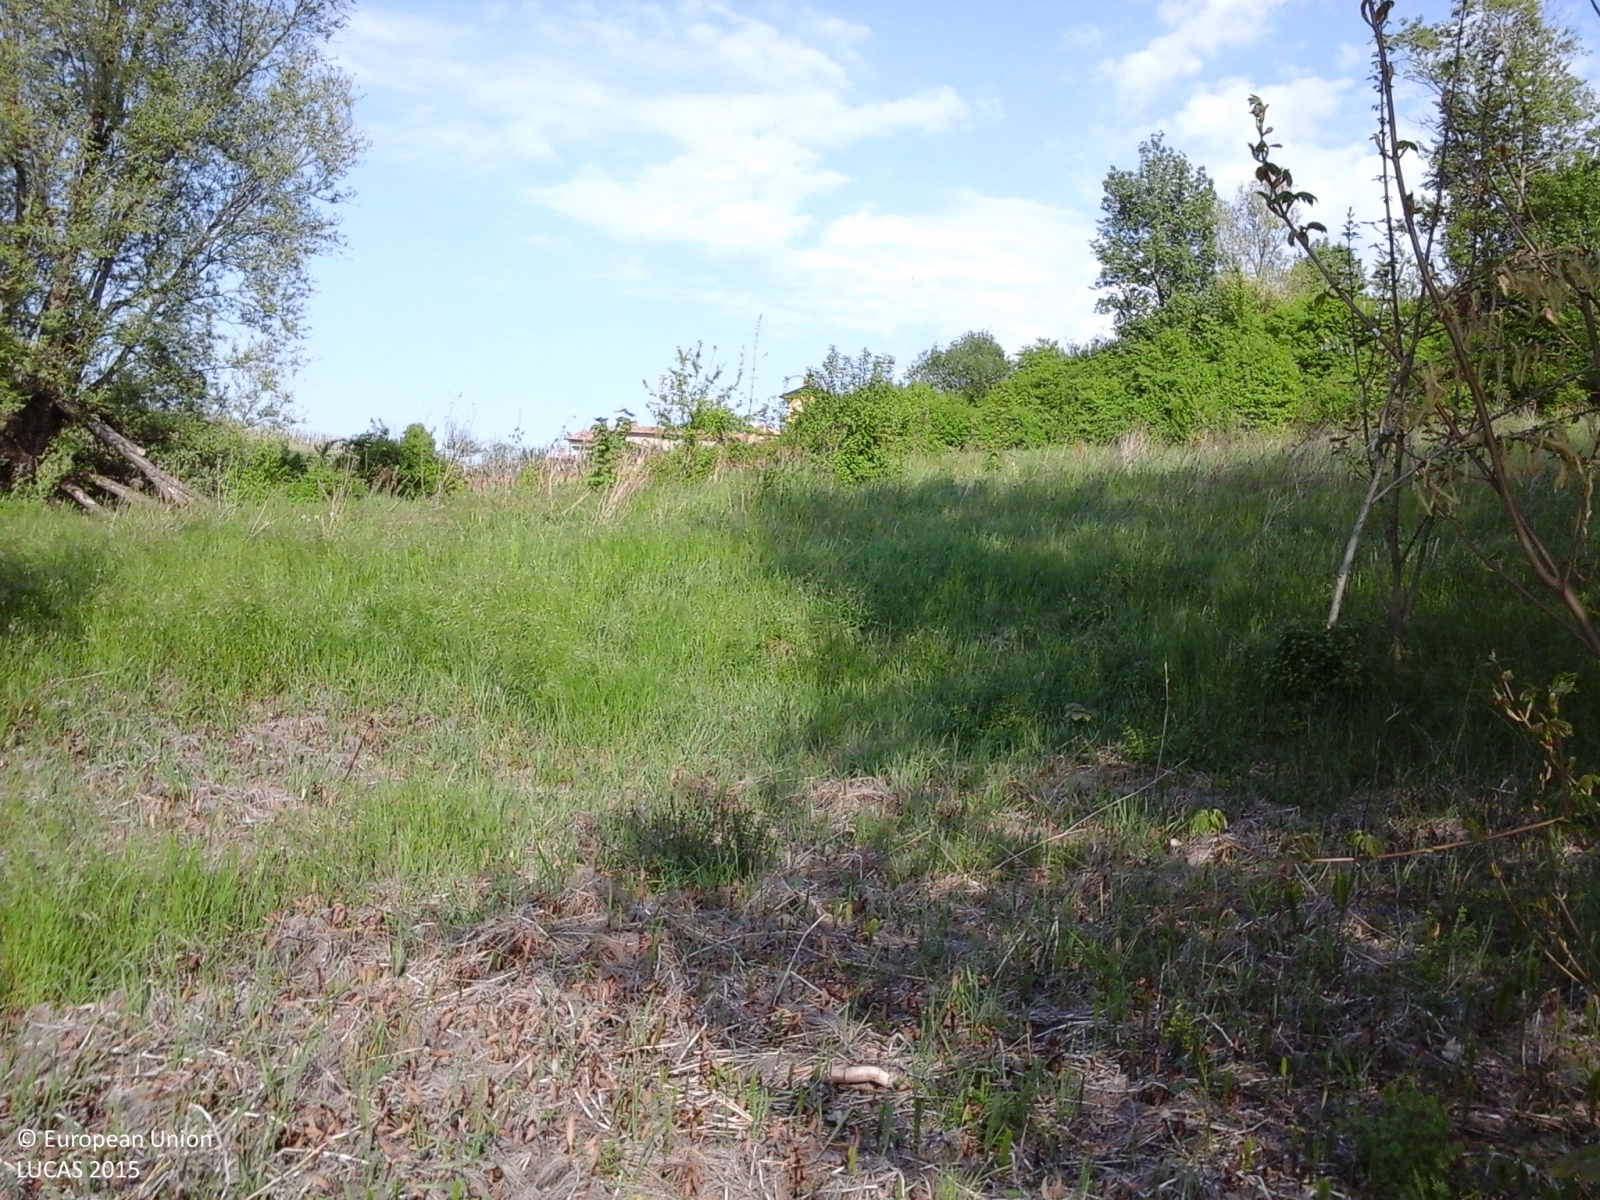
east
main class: Woodland
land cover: Broadleaved woodland
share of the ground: > 75 %
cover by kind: herbaceous plants 70 %, broadleaved forest trees 30 %
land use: Semi-natural and natural areas not in use
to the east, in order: Broadleaved woodland; Grassland without tree/shrub cover; Broadleaved woodland; Managed hedges; Fences; Other fruit trees and berries; Electric lines; Other fruit trees and berries; Fences; Grass margins; Vineyards; Artificial constructions in urban areas; Spontaneously vegetated surfaces; Electric lines; Spontaneously vegetated surfaces
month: April
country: IT
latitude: 44.9979
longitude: 9.3796
